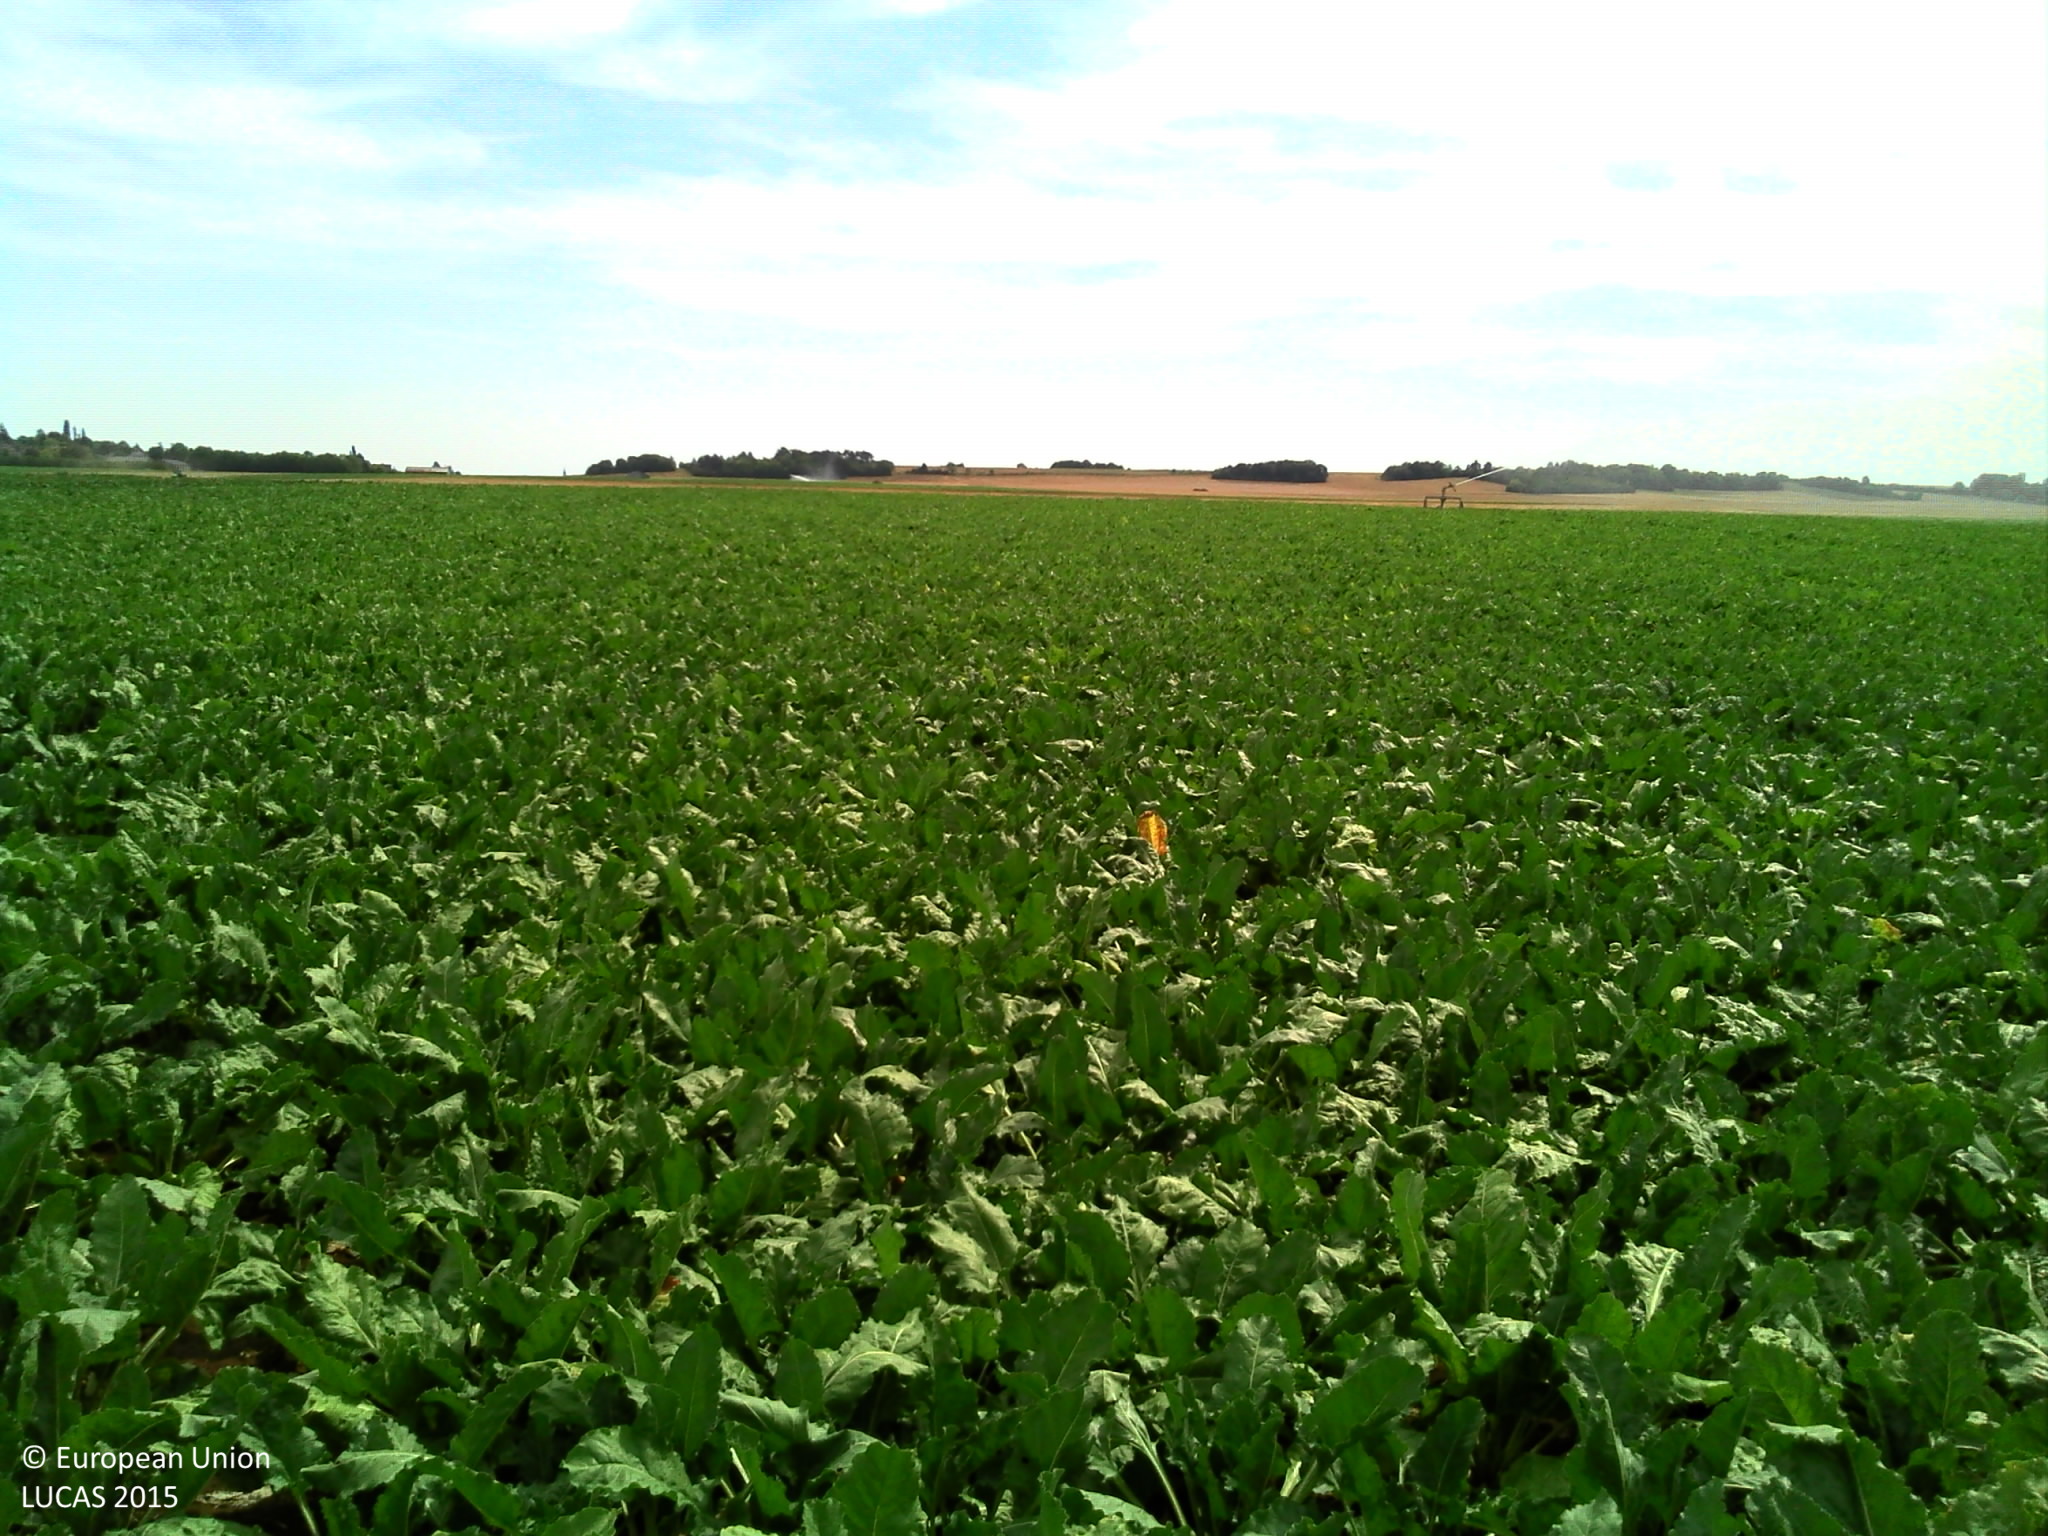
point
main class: Cropland
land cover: Sugar beet
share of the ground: > 75 %
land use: Agriculture (excluding fallow land and kitchen gardens)
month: August
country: FR
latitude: 48.2383
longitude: 2.4901
